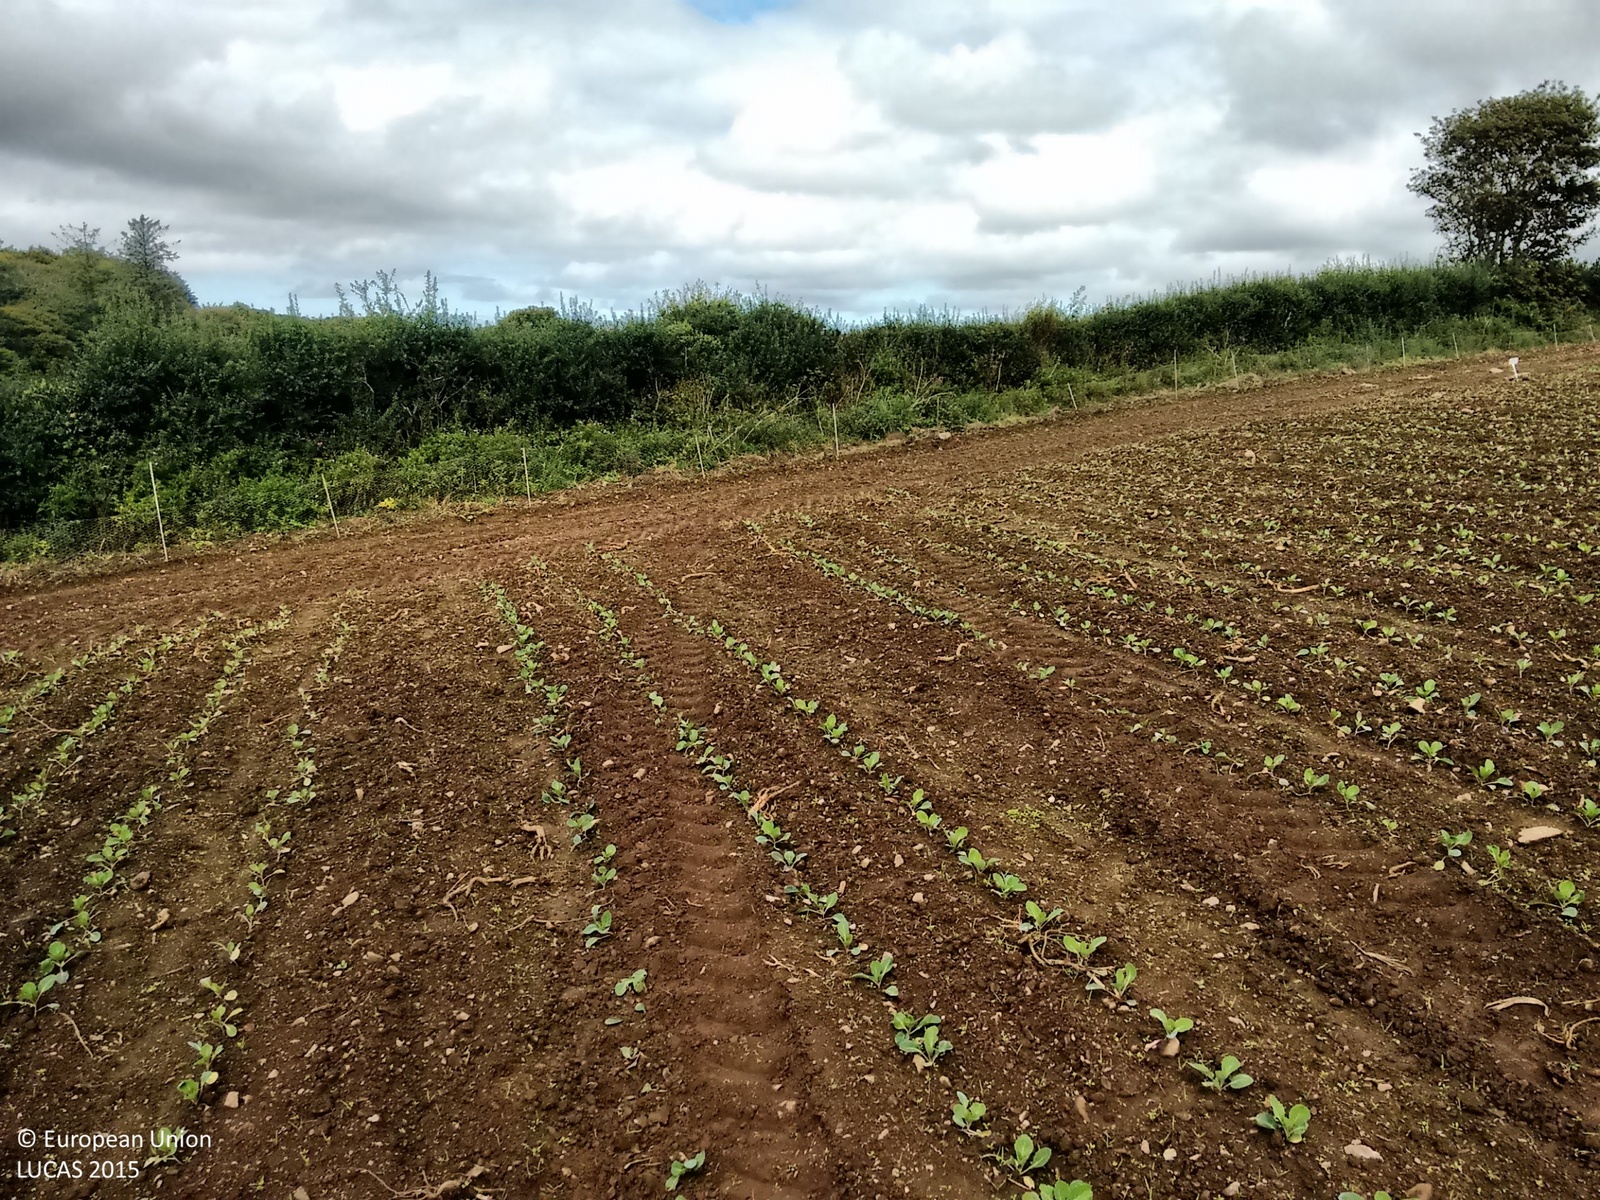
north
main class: Cropland
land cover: Other fresh vegetables
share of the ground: < 10 %
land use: Agriculture (excluding fallow land and kitchen gardens)
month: September
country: GB
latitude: 50.1319
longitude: -5.3012
